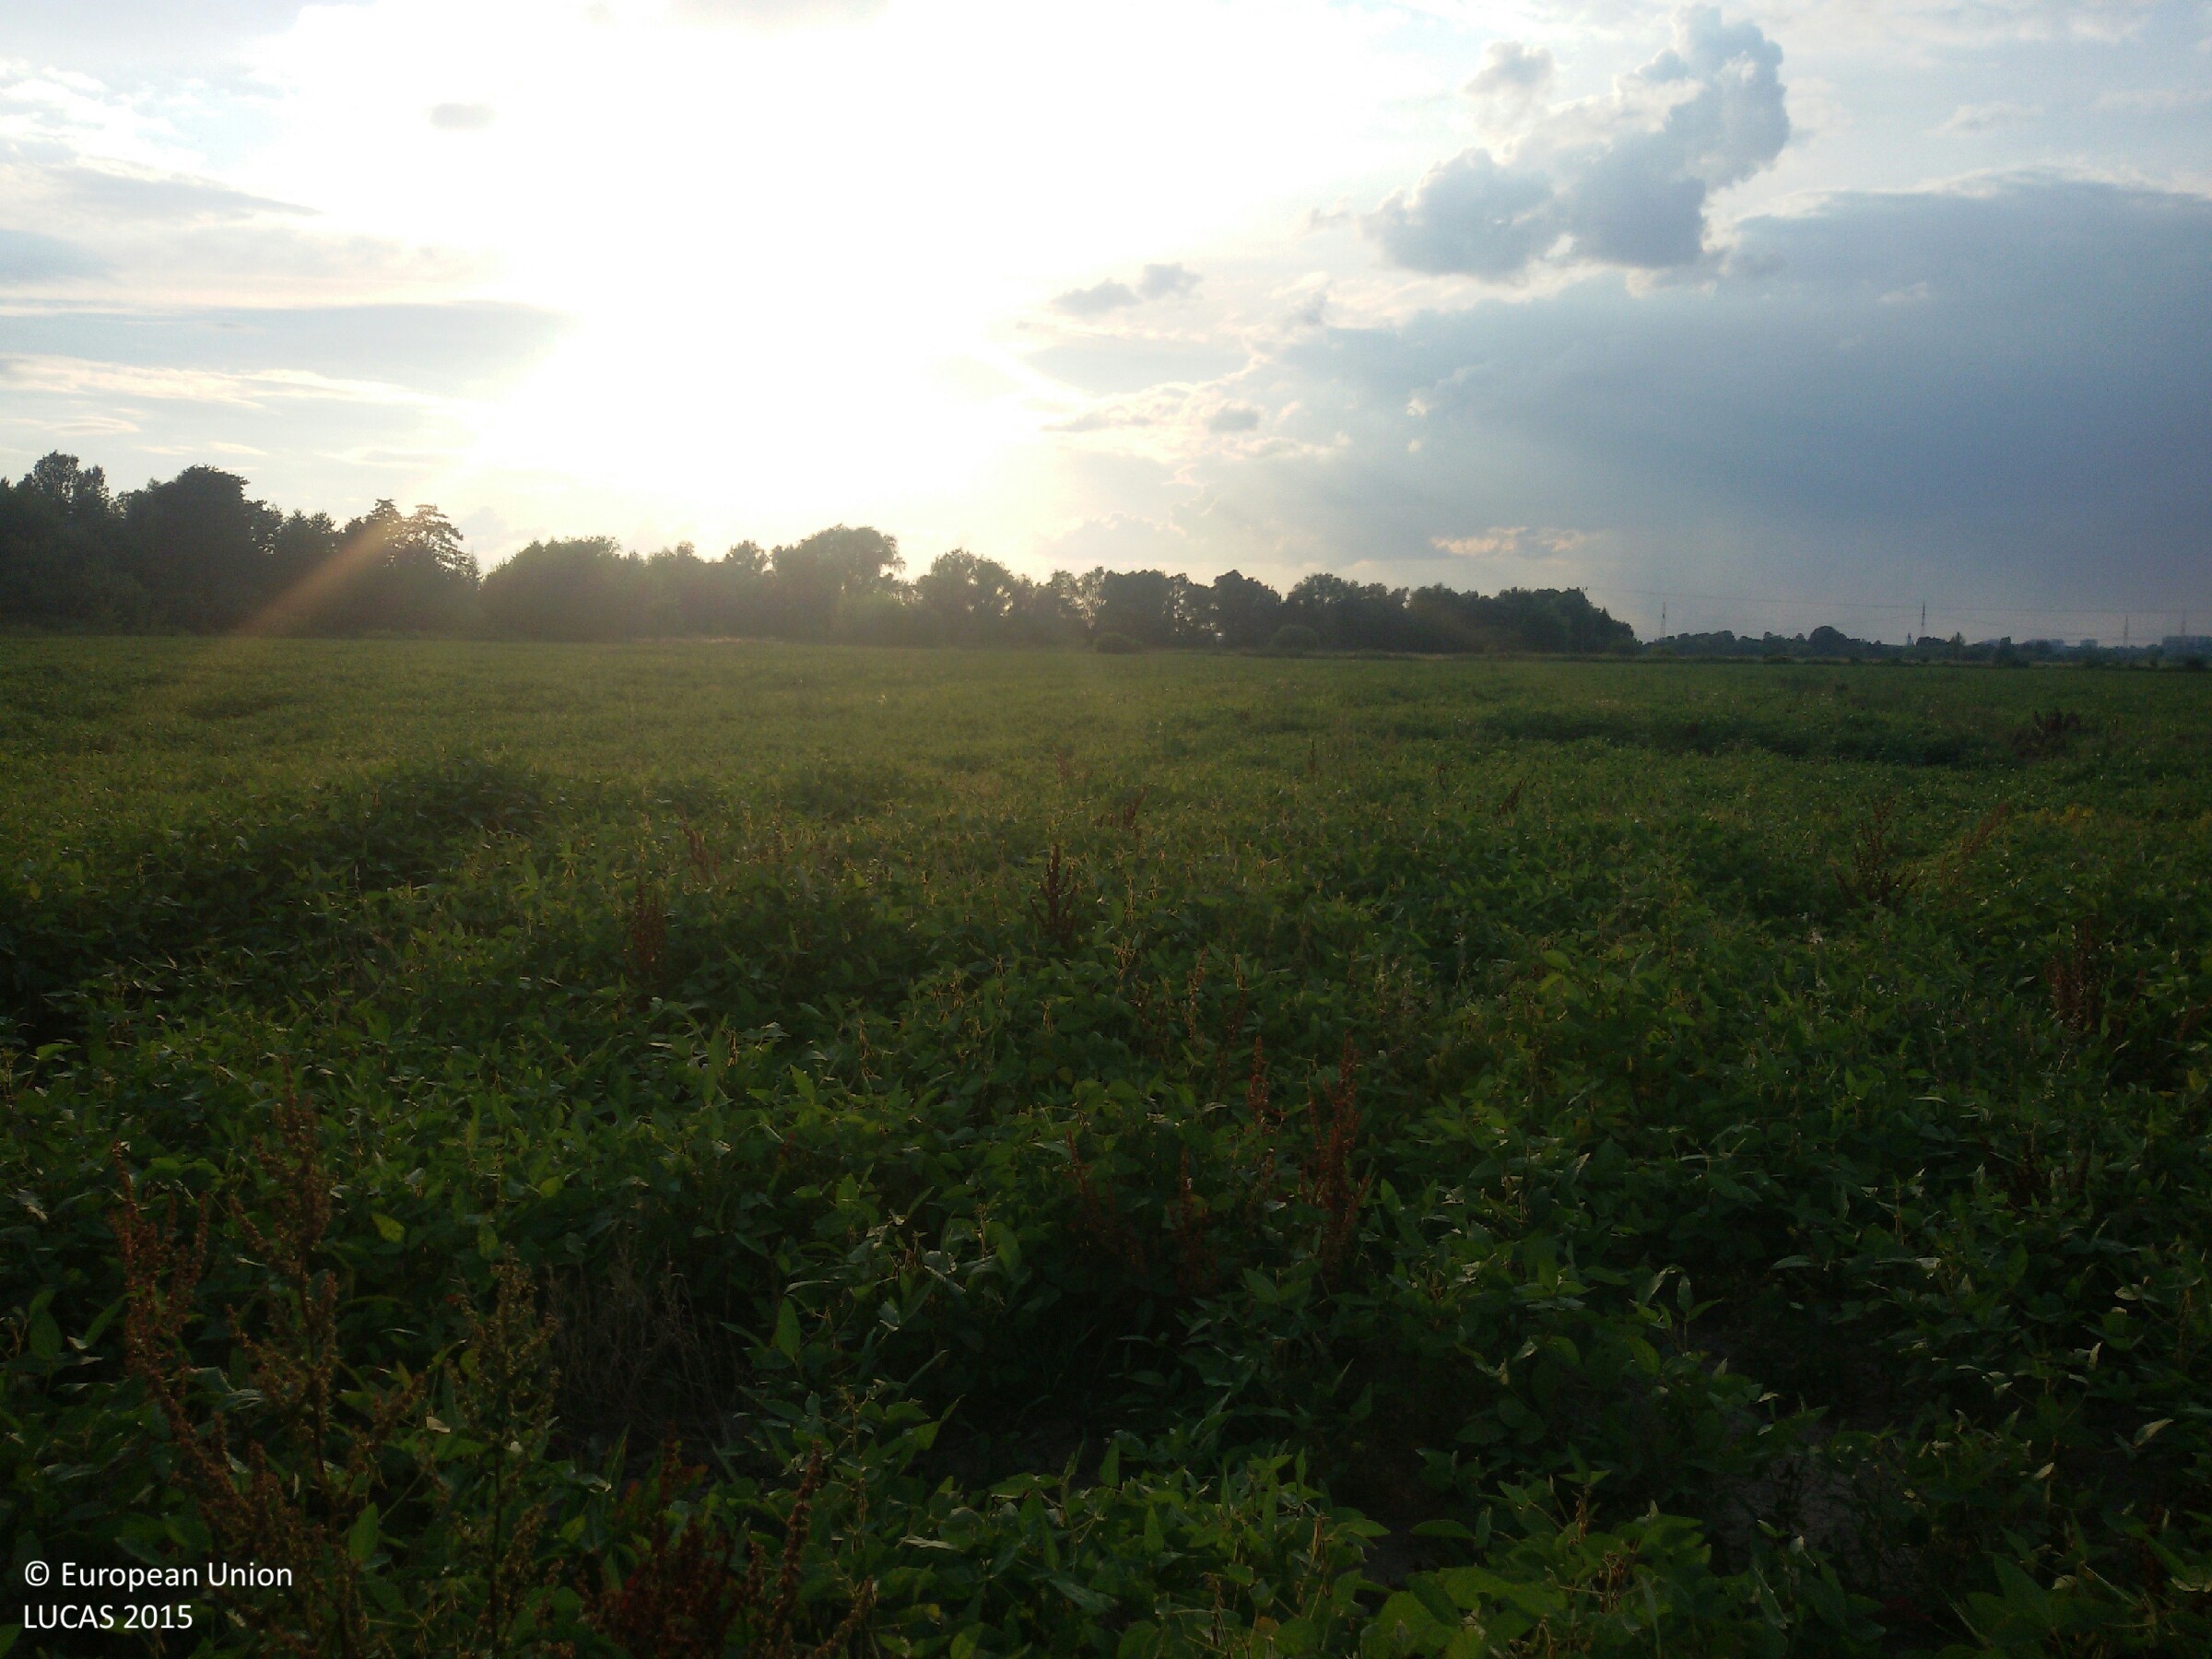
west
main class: Cropland
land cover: Soya
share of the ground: > 75 %
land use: Agriculture (excluding fallow land and kitchen gardens)
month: August
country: PL
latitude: 50.9138
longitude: 21.4431
